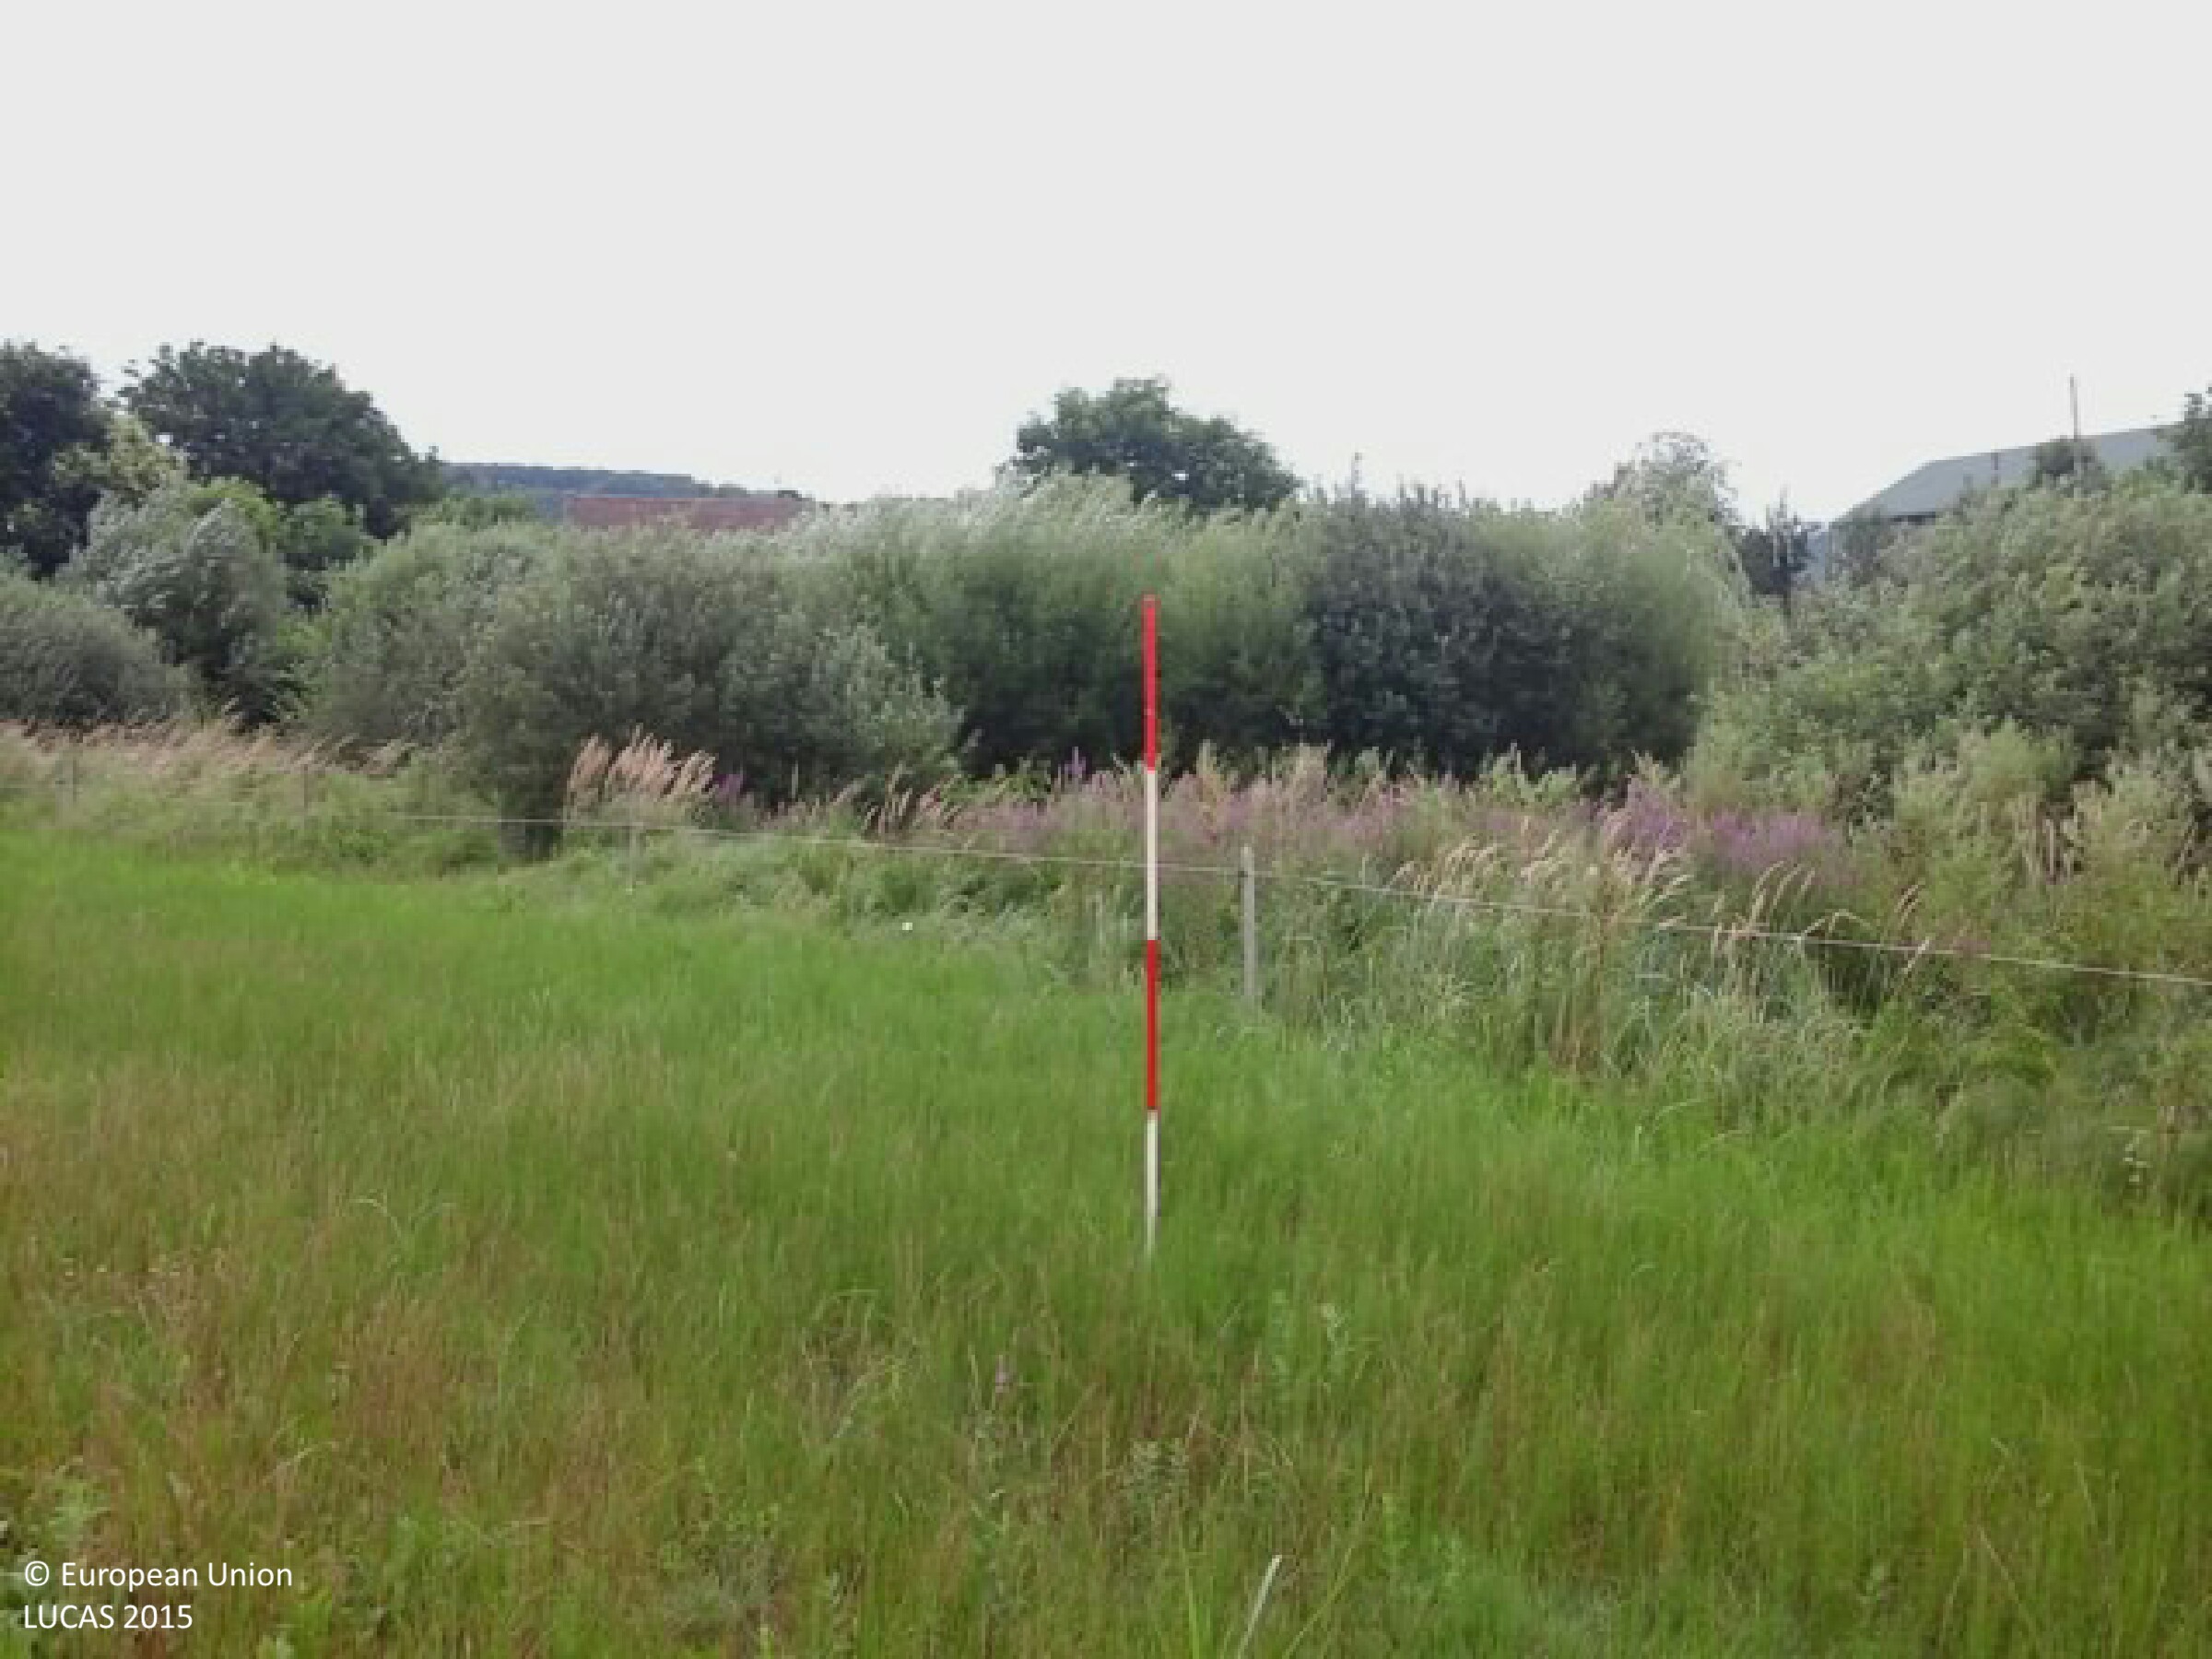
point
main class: Grassland
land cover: Grassland without tree/shrub cover
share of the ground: > 75 %
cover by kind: herbaceous plants 100 %
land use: Agriculture (excluding fallow land and kitchen gardens)
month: July
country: HU
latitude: 46.2138
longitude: 18.0043
